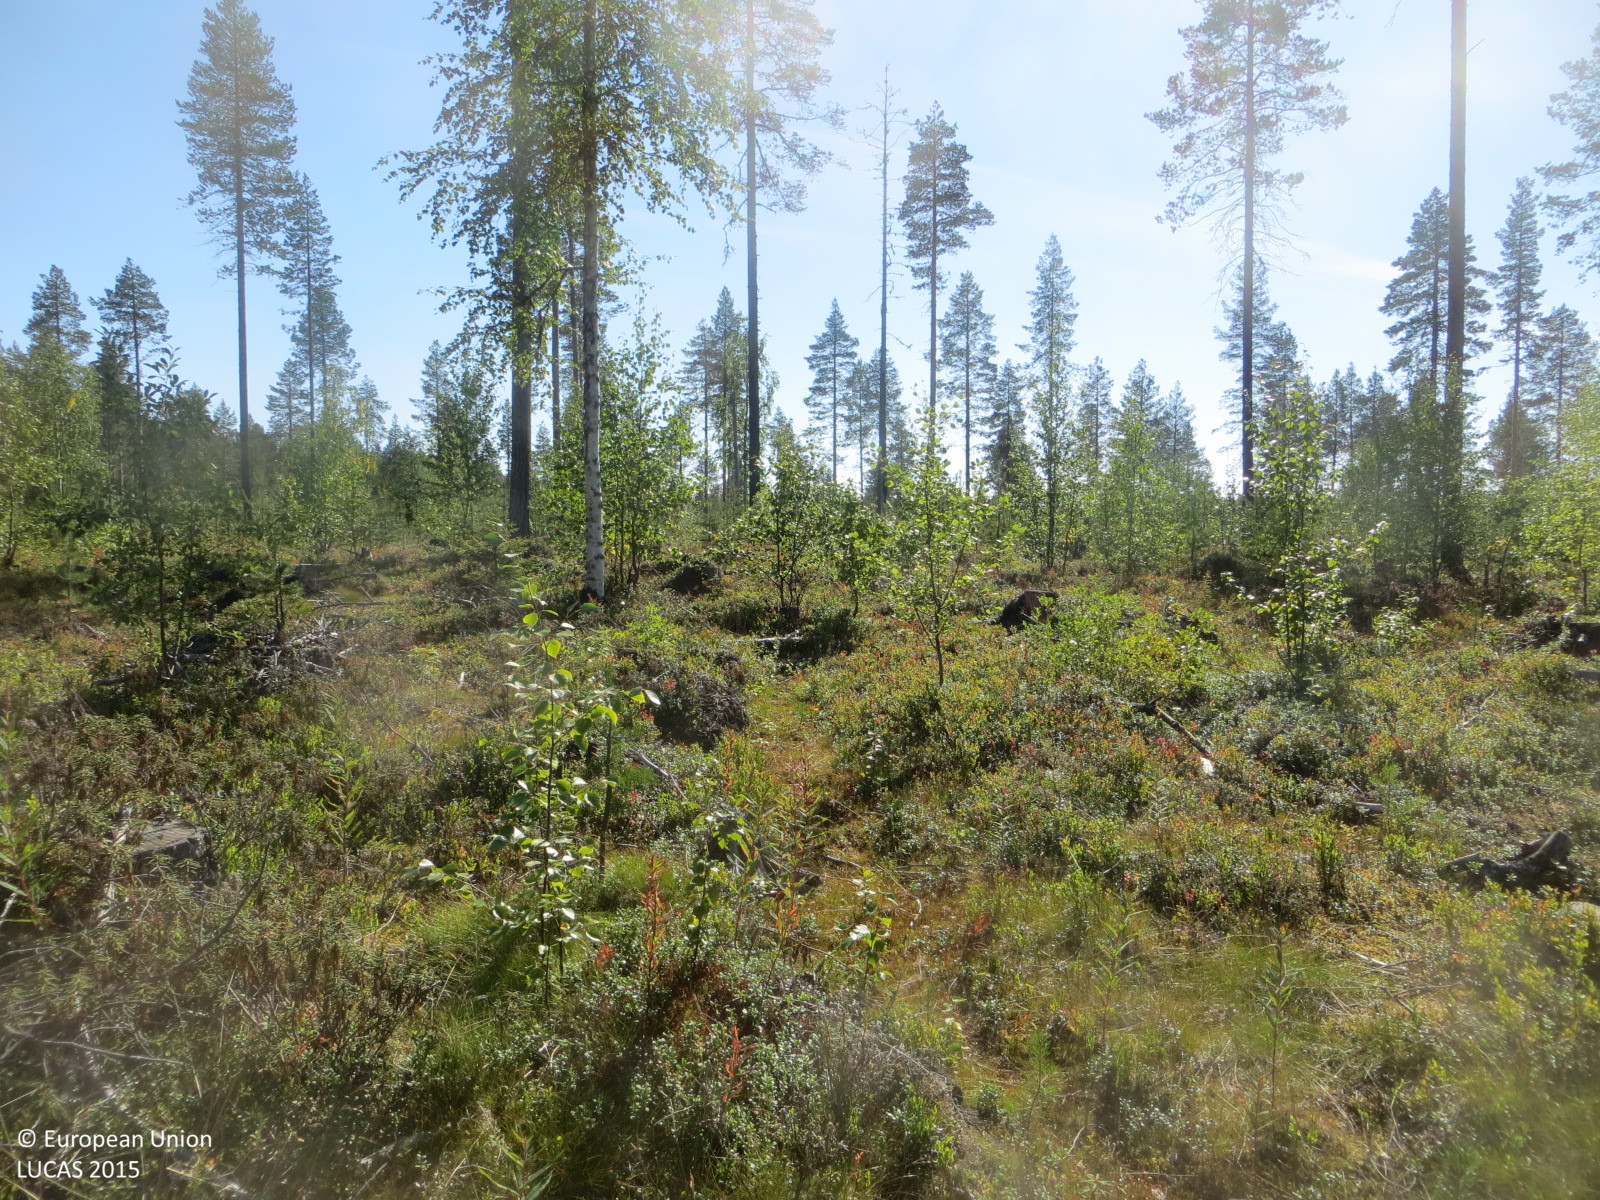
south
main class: Woodland
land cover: Pine dominated mixed woodland
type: boreal forest
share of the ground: 10 - 25 %
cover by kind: shrubs 80 %, coniferous forest trees 10 %, broadleaved forest trees 10 %
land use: Forestry
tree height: > 5 m
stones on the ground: < 10 %
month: August
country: FI
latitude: 67.4458
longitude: 23.7340
